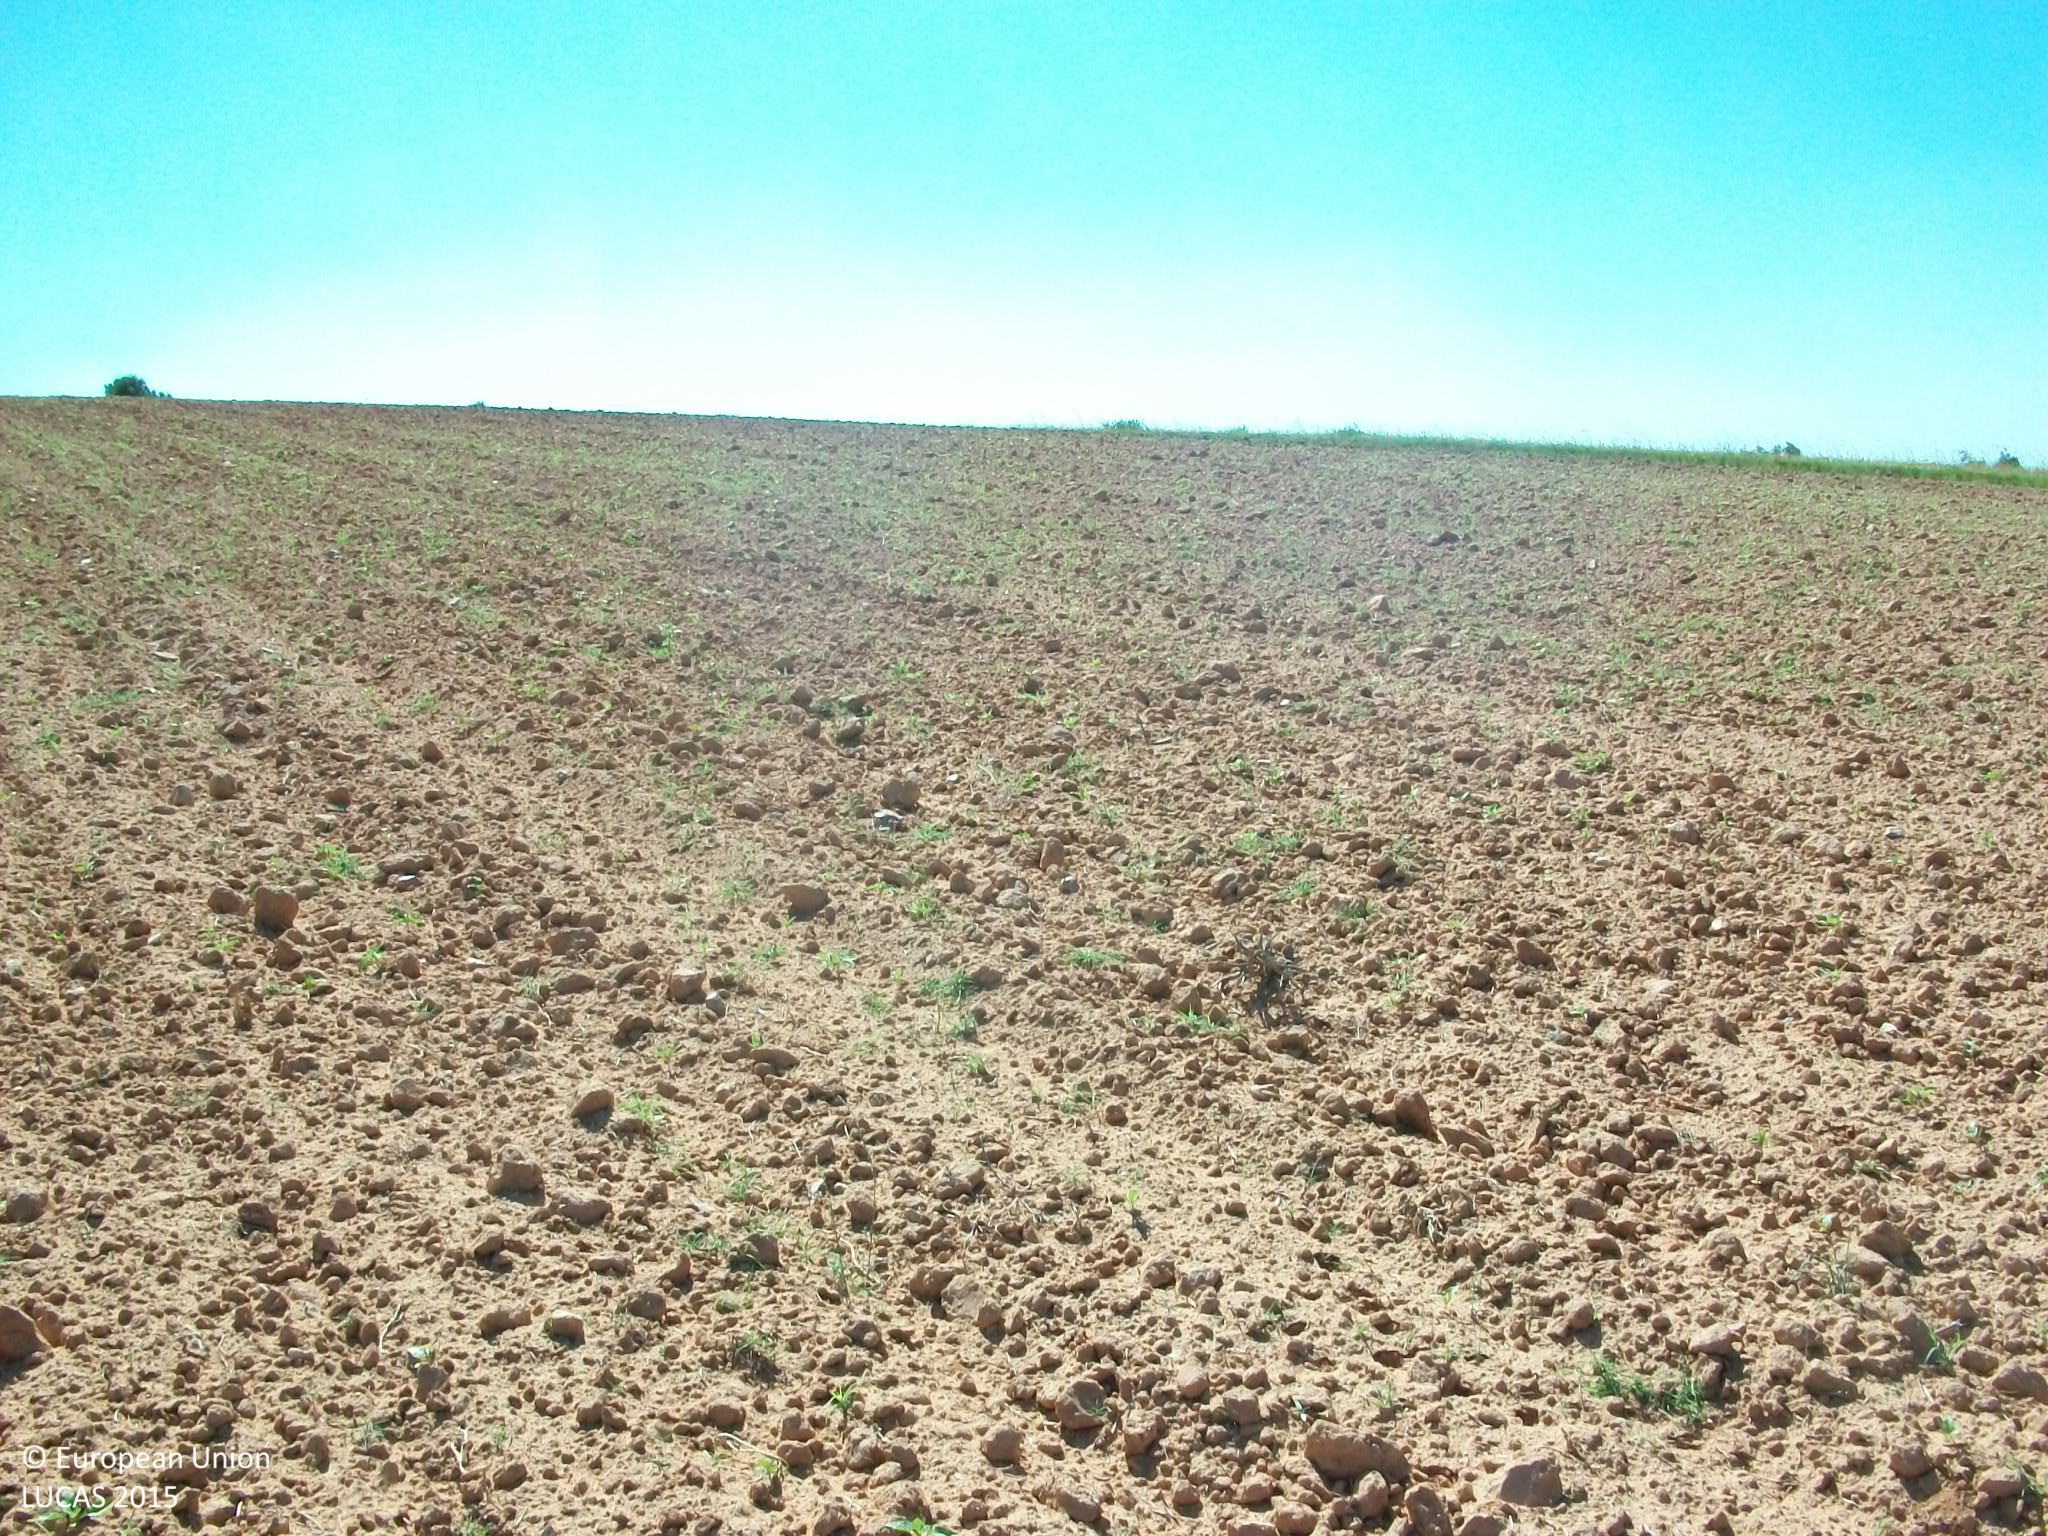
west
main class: Cropland
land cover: Dry pulses
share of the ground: < 10 %
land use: Agriculture (excluding fallow land and kitchen gardens)
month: May
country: ES
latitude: 39.8261
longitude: -3.6167
